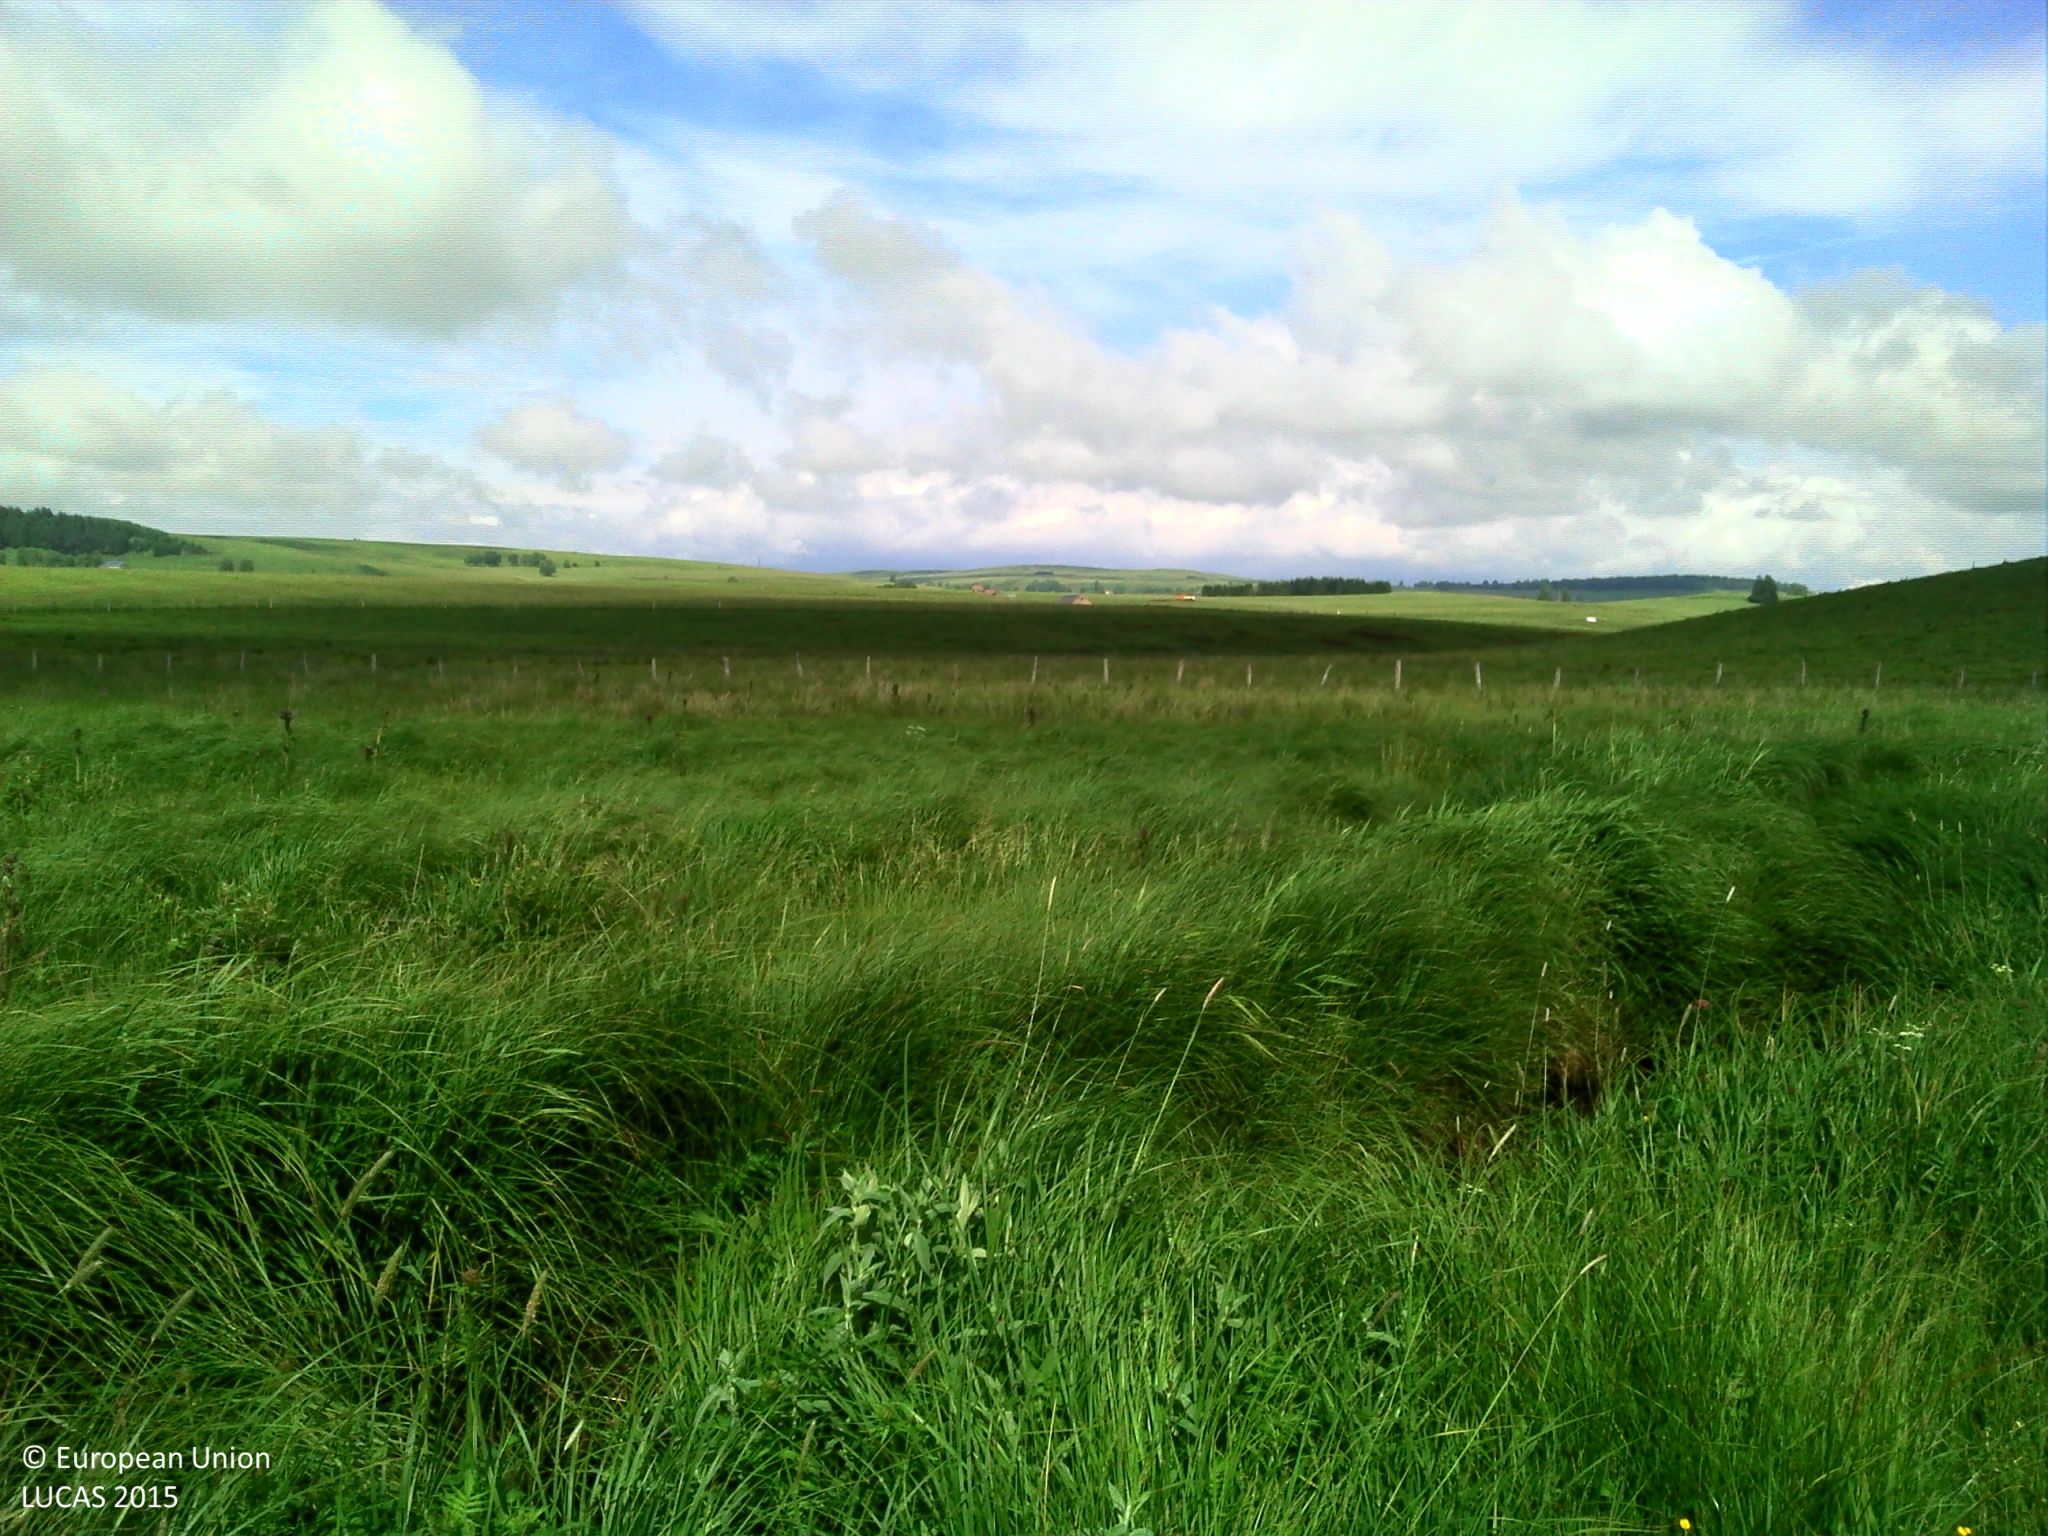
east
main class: Grassland
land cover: Grassland without tree/shrub cover
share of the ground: > 75 %
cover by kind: herbaceous plants 100 %
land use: Agriculture (excluding fallow land and kitchen gardens)
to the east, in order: Grassland without tree/shrub cover; Rivers and streams; Grassland without tree/shrub cover; Fences; Grassland without tree/shrub cover; Rivers and streams; Grassland without tree/shrub cover
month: June
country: FR
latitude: 45.2636
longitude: 2.8766
